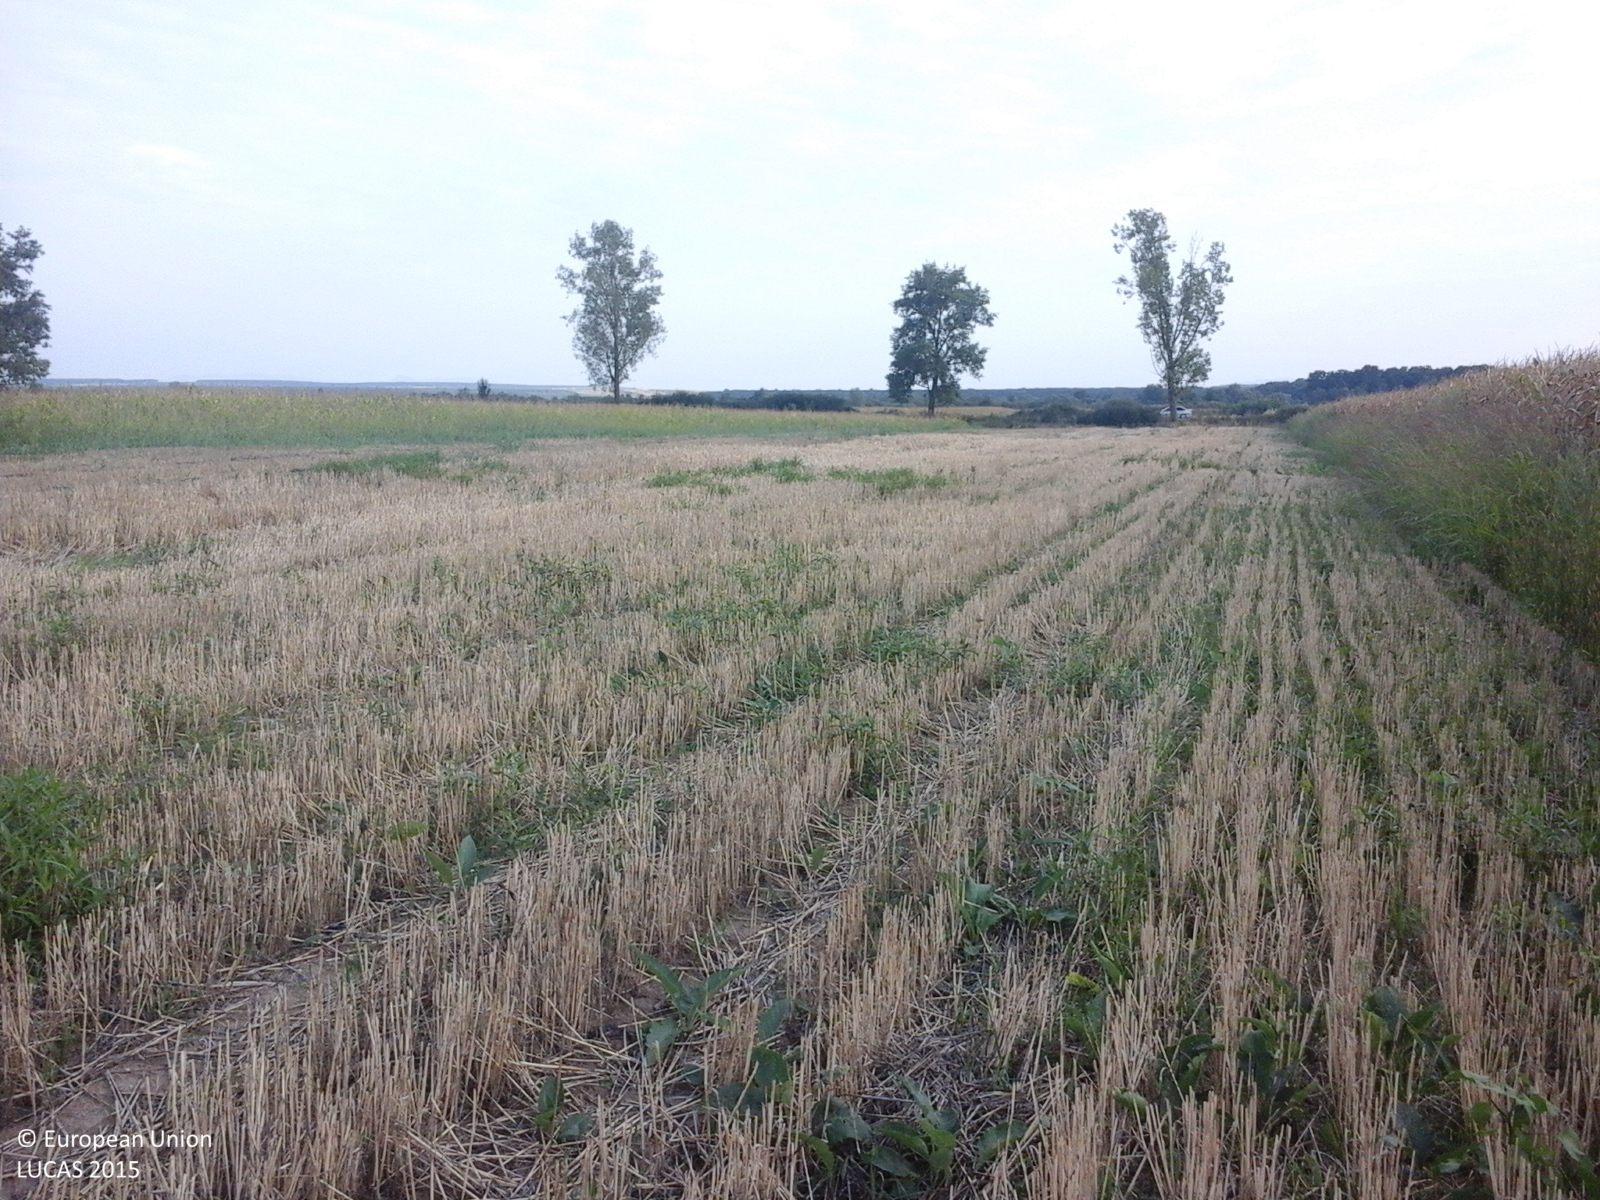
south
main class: Cropland
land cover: Maize
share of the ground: > 75 %
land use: Agriculture (excluding fallow land and kitchen gardens)
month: August
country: RO
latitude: 46.4305
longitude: 21.8980
